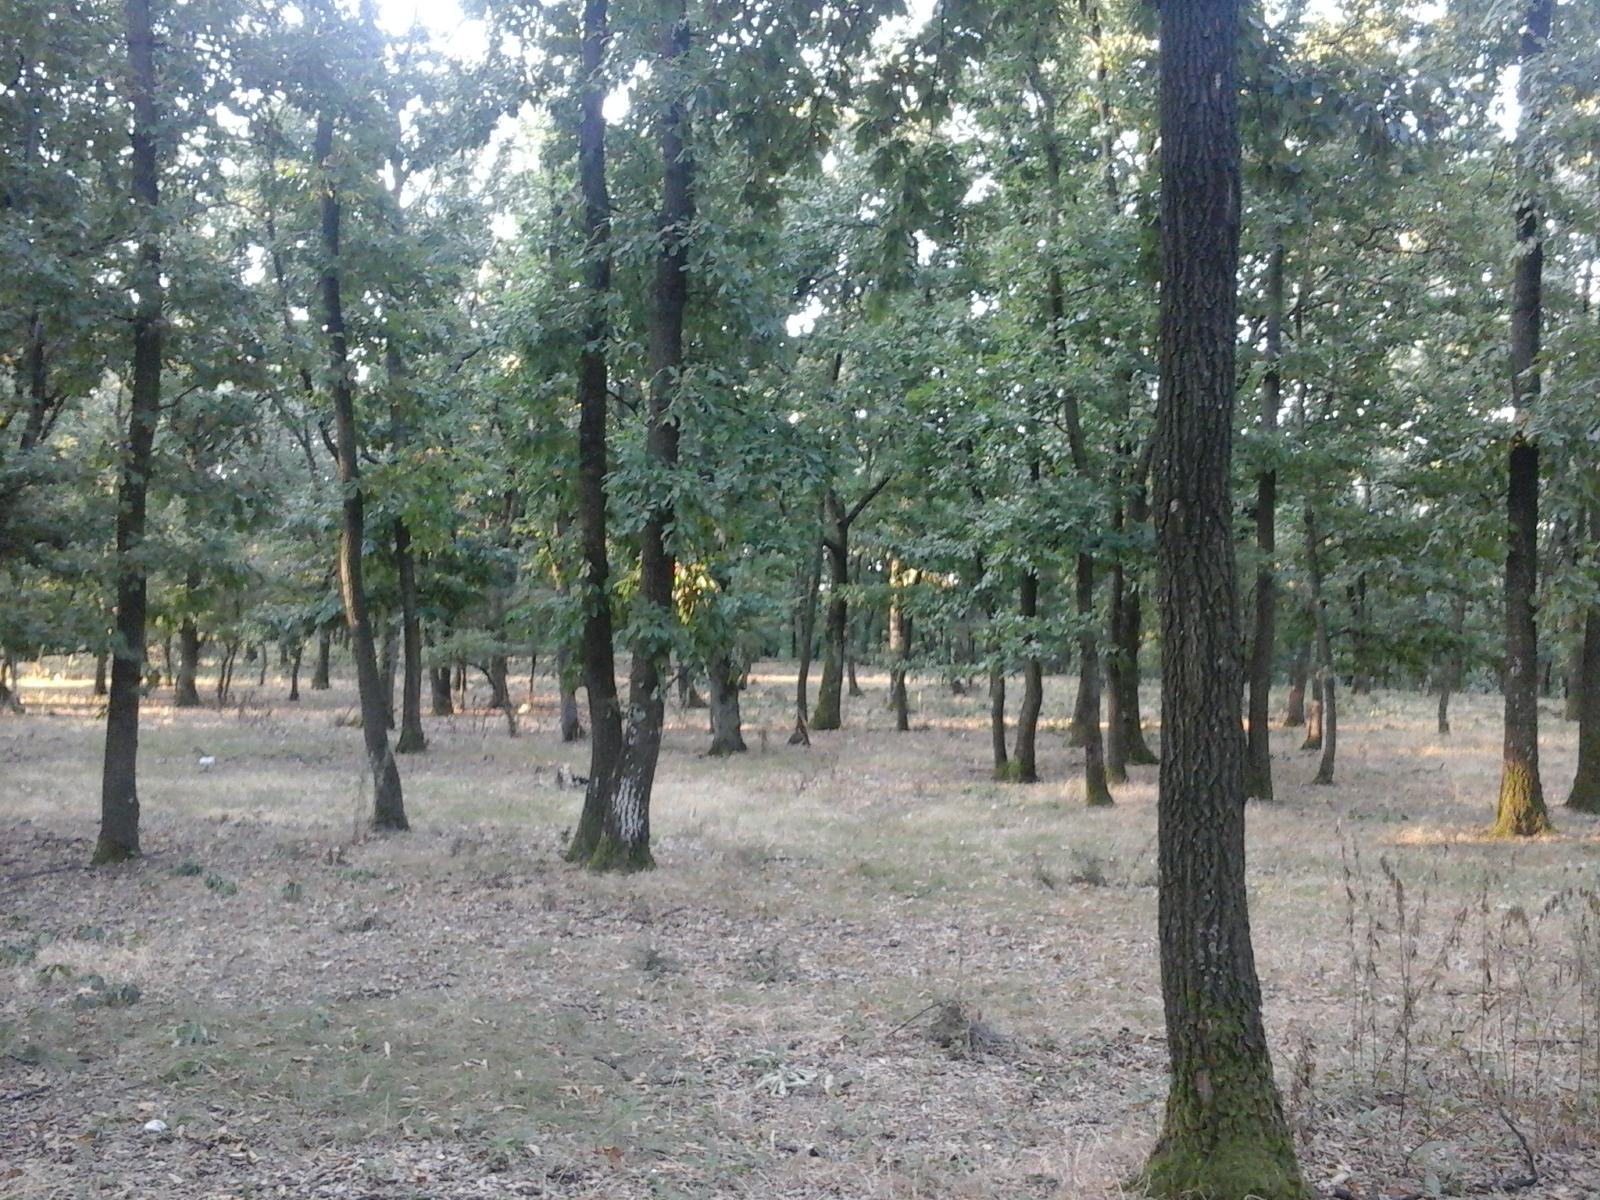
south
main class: Woodland
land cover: Broadleaved woodland
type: acidophilous oak and oak-birch forest
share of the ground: > 75 %
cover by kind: broadleaved forest trees 100 %
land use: Forestry
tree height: > 5 m
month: August
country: RO
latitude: 44.1936
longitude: 23.7807
